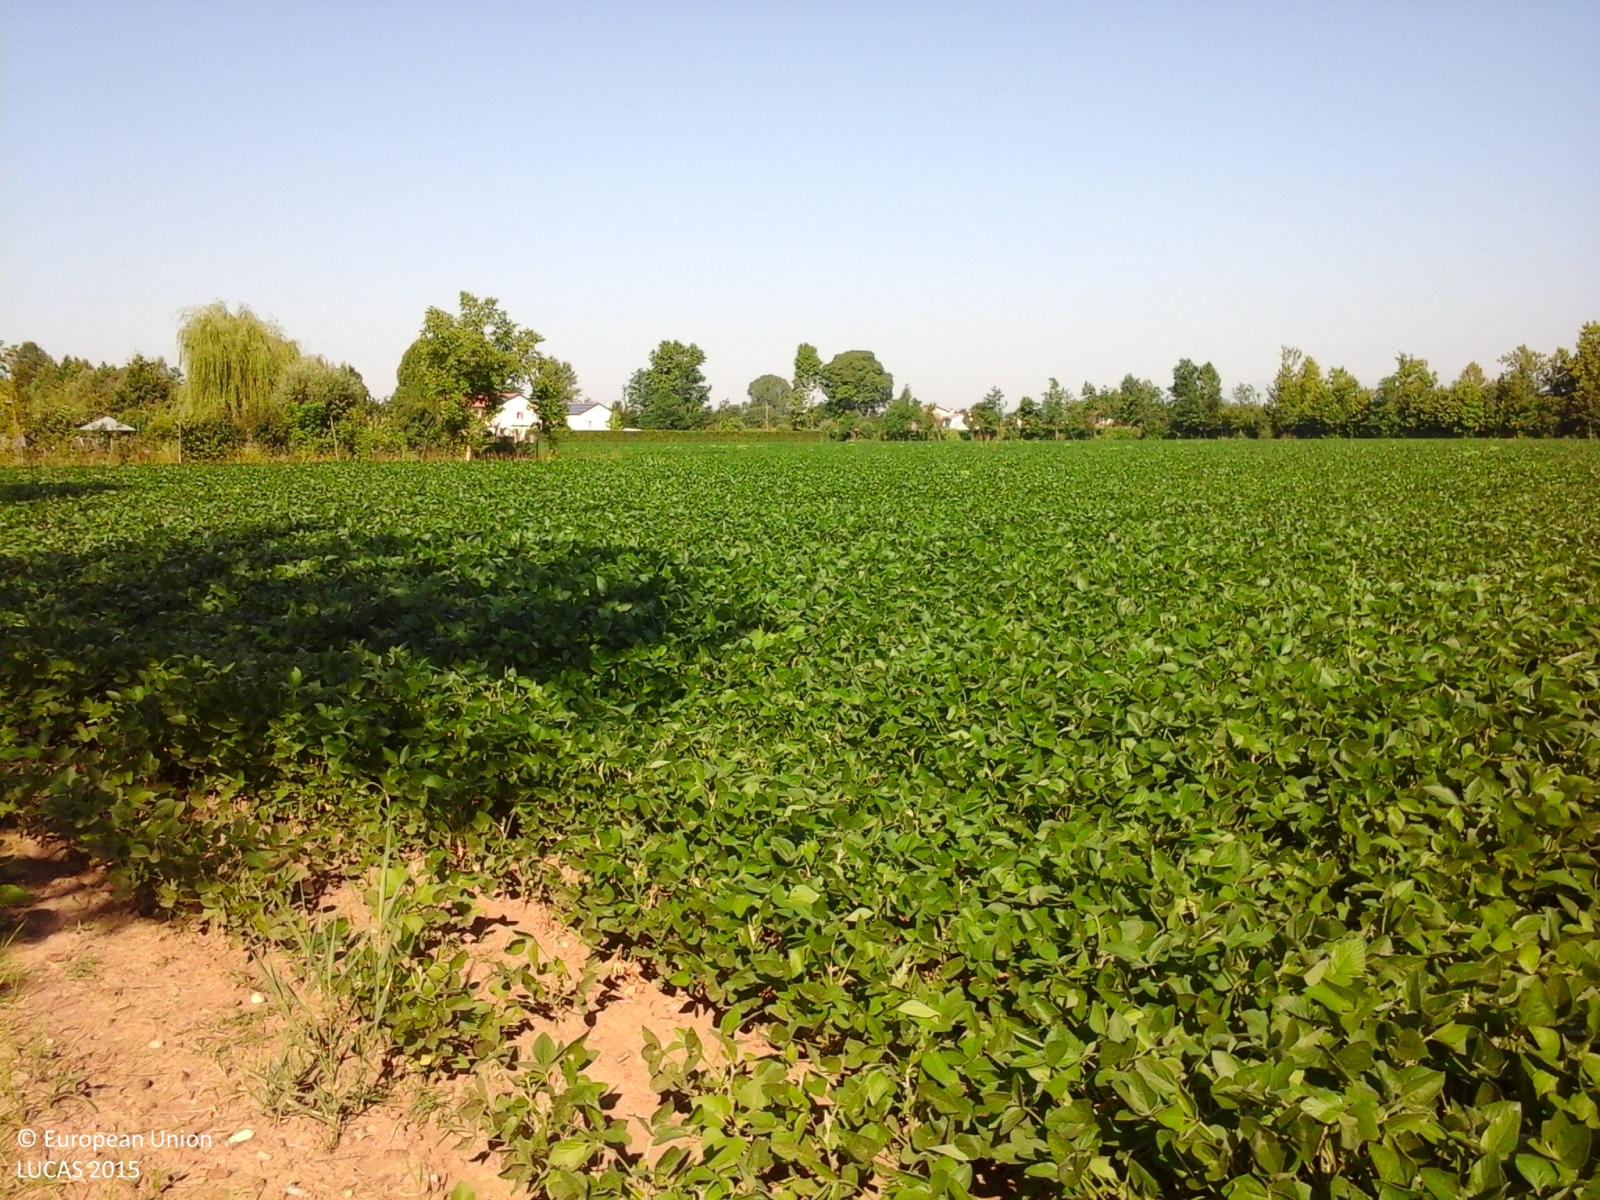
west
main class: Cropland
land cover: Soya
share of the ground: > 75 %
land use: Agriculture (excluding fallow land and kitchen gardens)
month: July
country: IT
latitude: 45.7307
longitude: 12.3482
